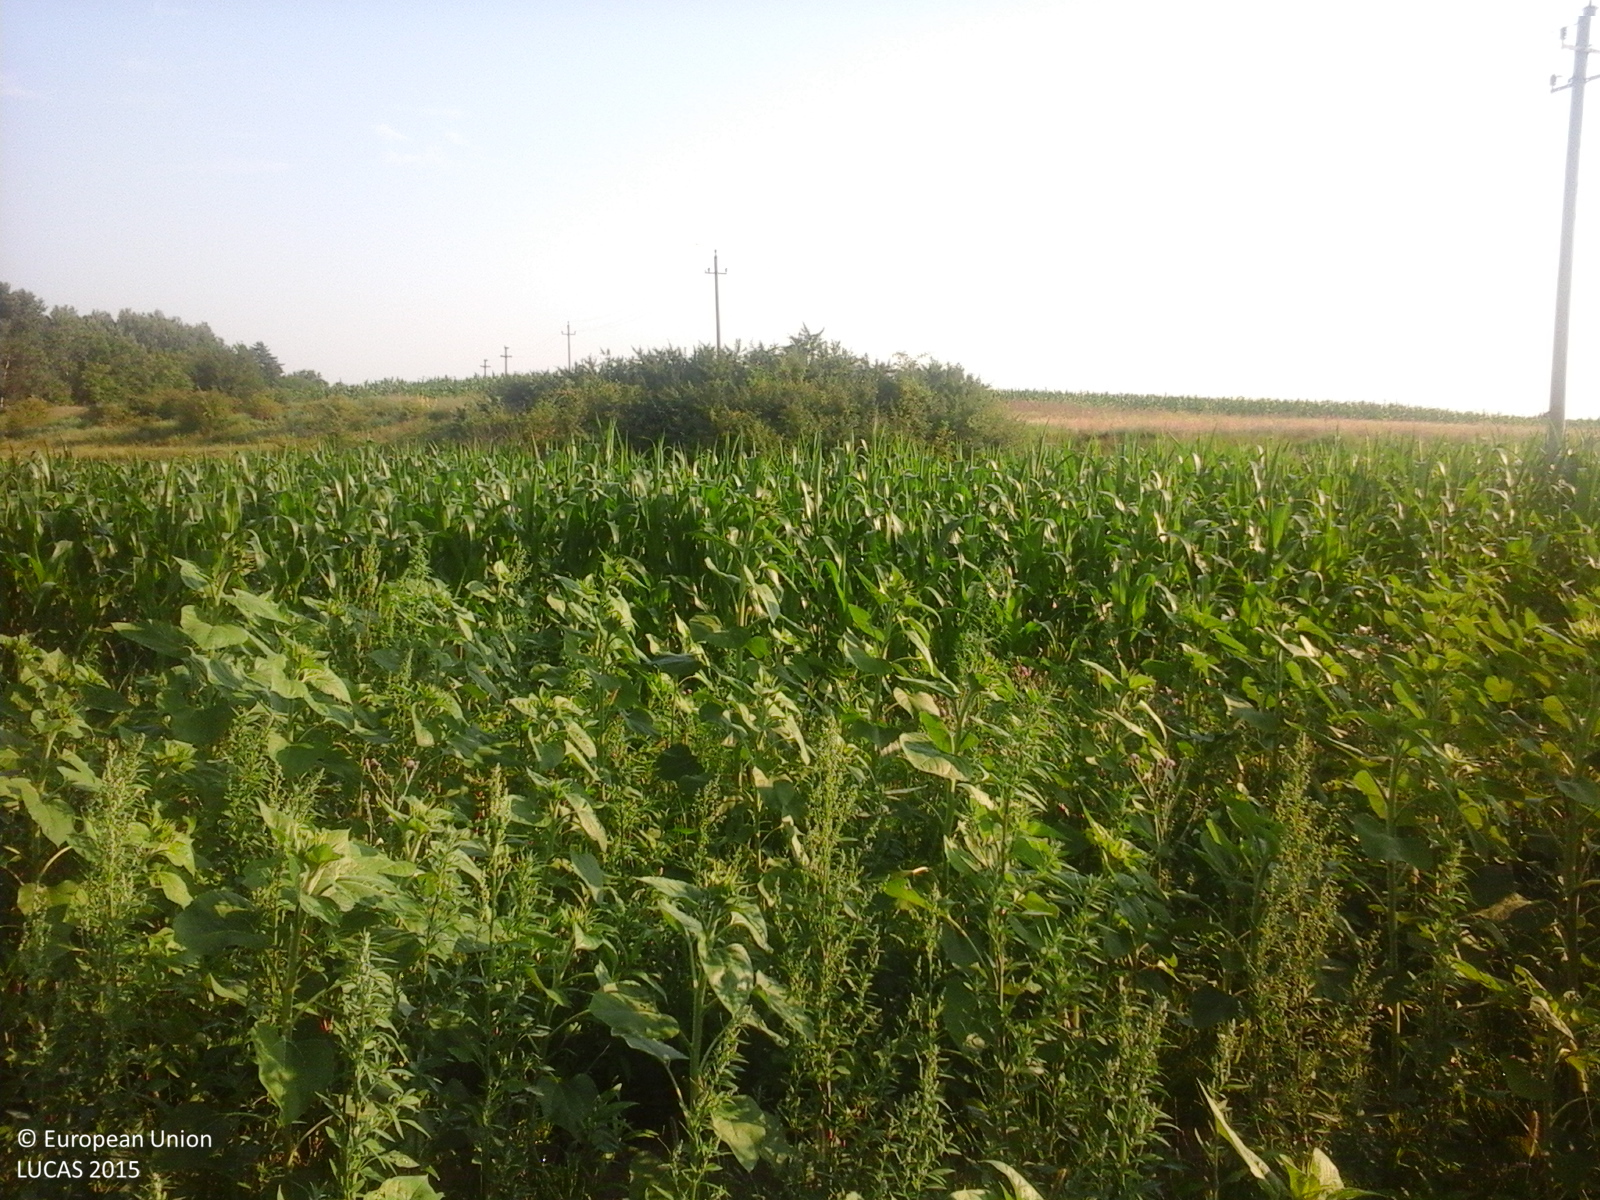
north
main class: Cropland
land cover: Sunflower
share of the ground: > 75 %
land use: Agriculture (excluding fallow land and kitchen gardens)
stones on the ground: < 10 %
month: July
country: RO
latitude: 44.4836
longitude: 24.7233
